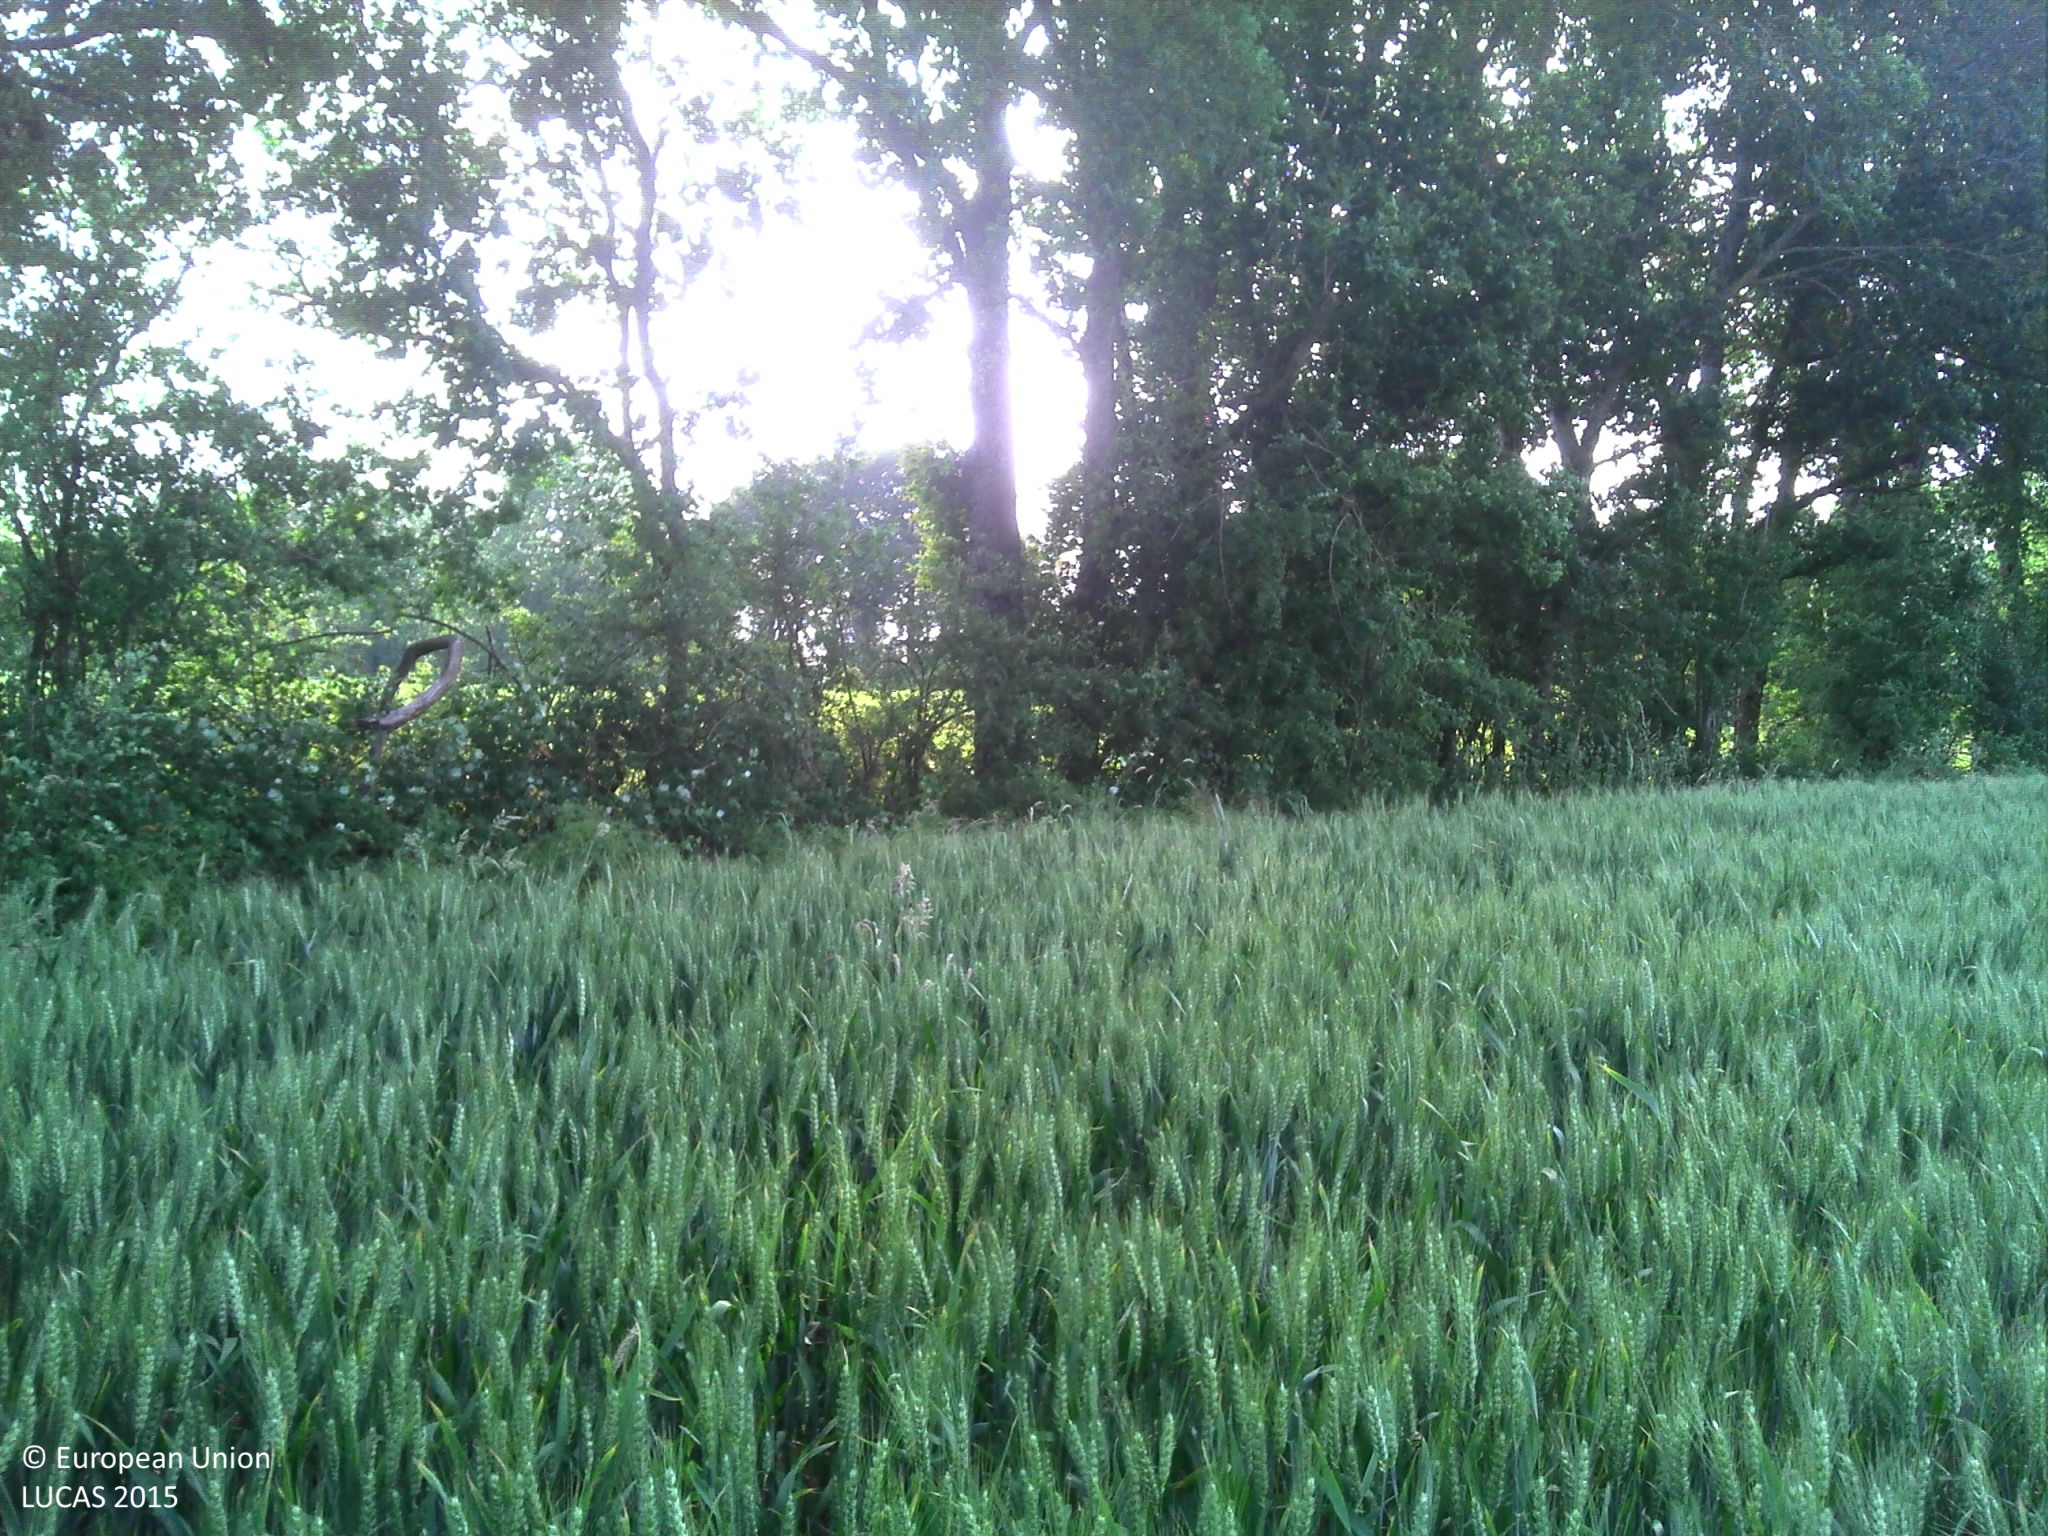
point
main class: Cropland
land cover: Common wheat
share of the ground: > 75 %
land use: Agriculture (excluding fallow land and kitchen gardens)
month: June
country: FR
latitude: 47.5391
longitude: 0.0772
